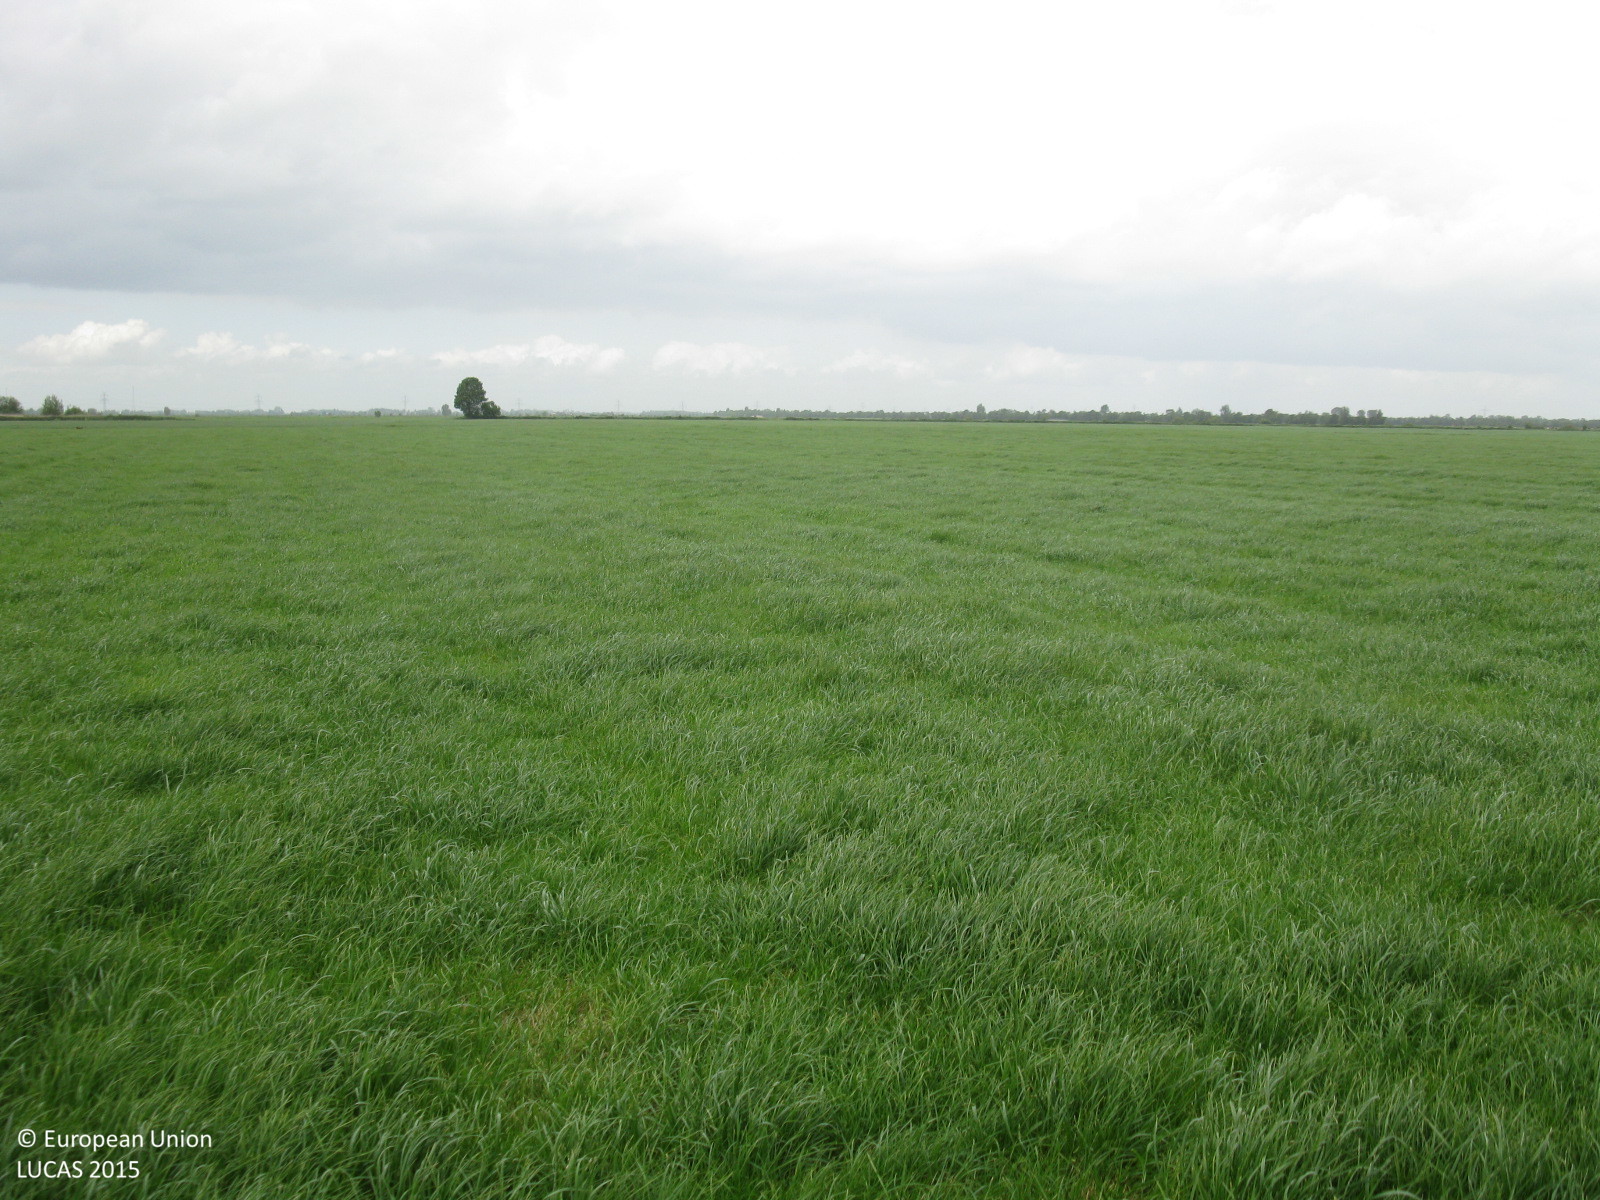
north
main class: Grassland
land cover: Grassland without tree/shrub cover
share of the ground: > 75 %
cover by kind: herbaceous plants 100 %
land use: Agriculture (excluding fallow land and kitchen gardens)
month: June
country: DE
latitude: 53.1220
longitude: 7.3856
